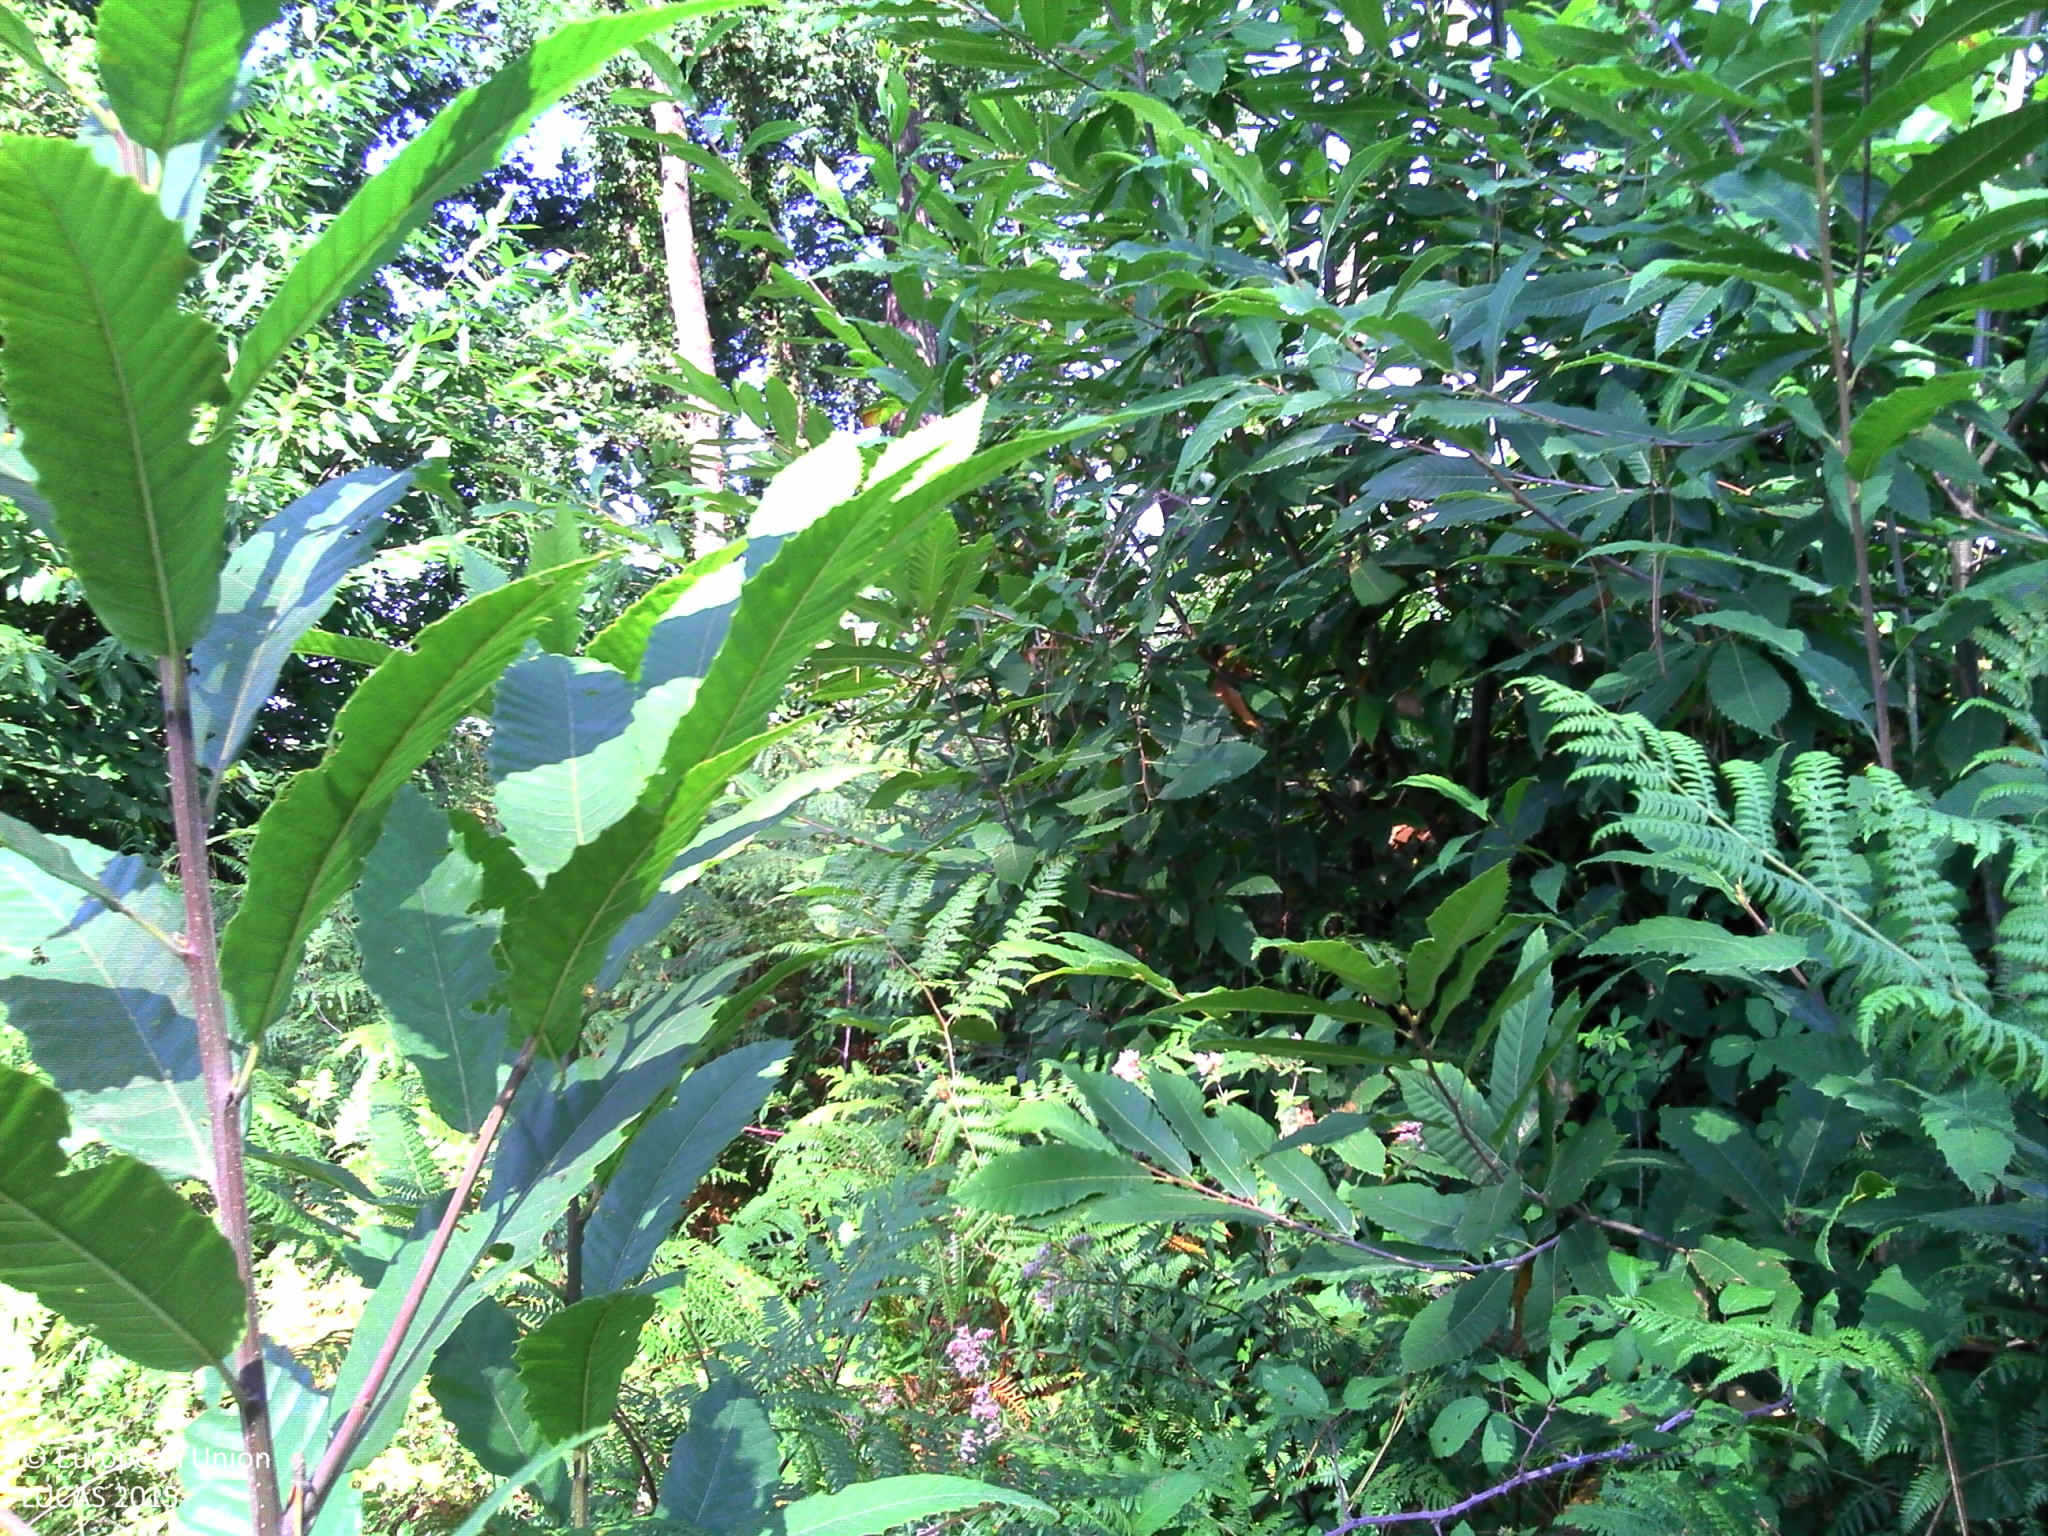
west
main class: Woodland
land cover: Pine dominated coniferous woodland
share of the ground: > 75 %
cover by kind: coniferous forest trees 80 %, herbaceous plants 15 %, shrubs 5 %
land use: Forestry
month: August
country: FR
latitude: 43.8070
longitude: -0.7662
